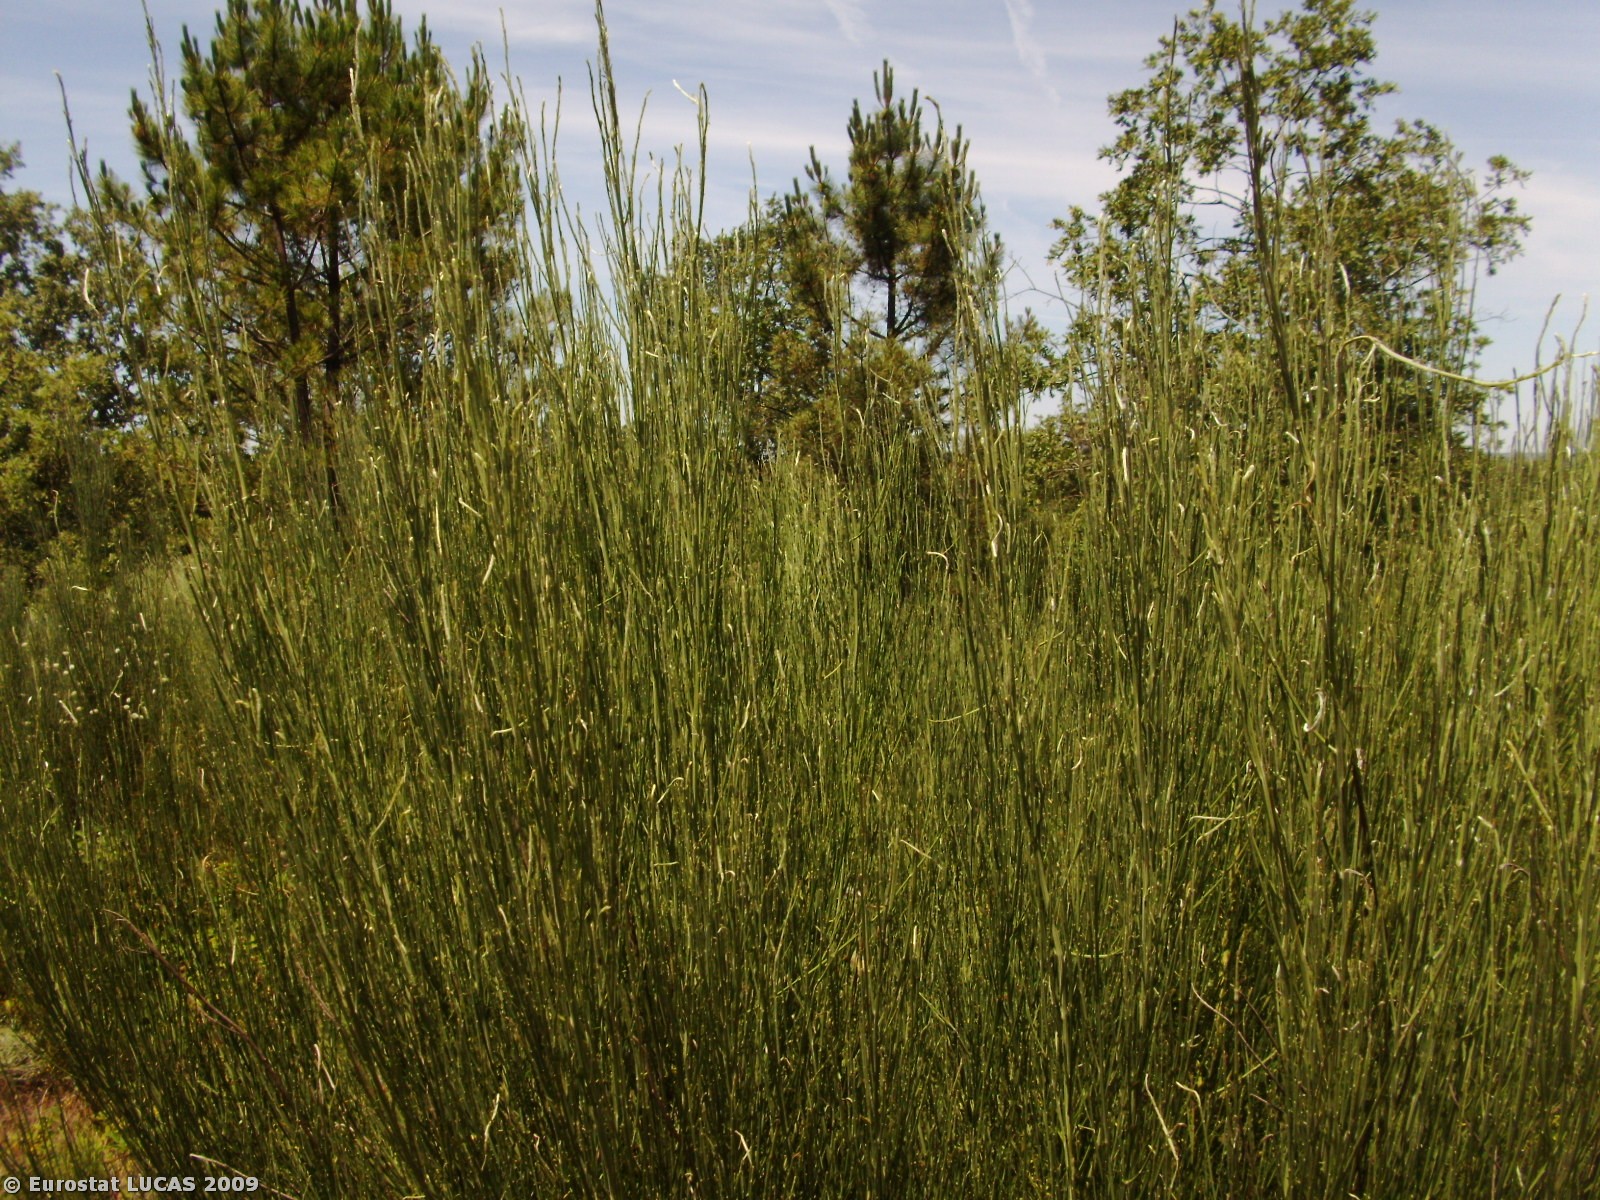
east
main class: Woodland
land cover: Mixed woodland
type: coniferous forest of the mediterranean region
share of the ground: > 75 %
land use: Forestry
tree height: > 5 m
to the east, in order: Mixed woodland; Broadleaved woodland; Coniferous woodland; Tracks; Broadleaved woodland
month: July
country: PT
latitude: 40.3798
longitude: -6.9752
